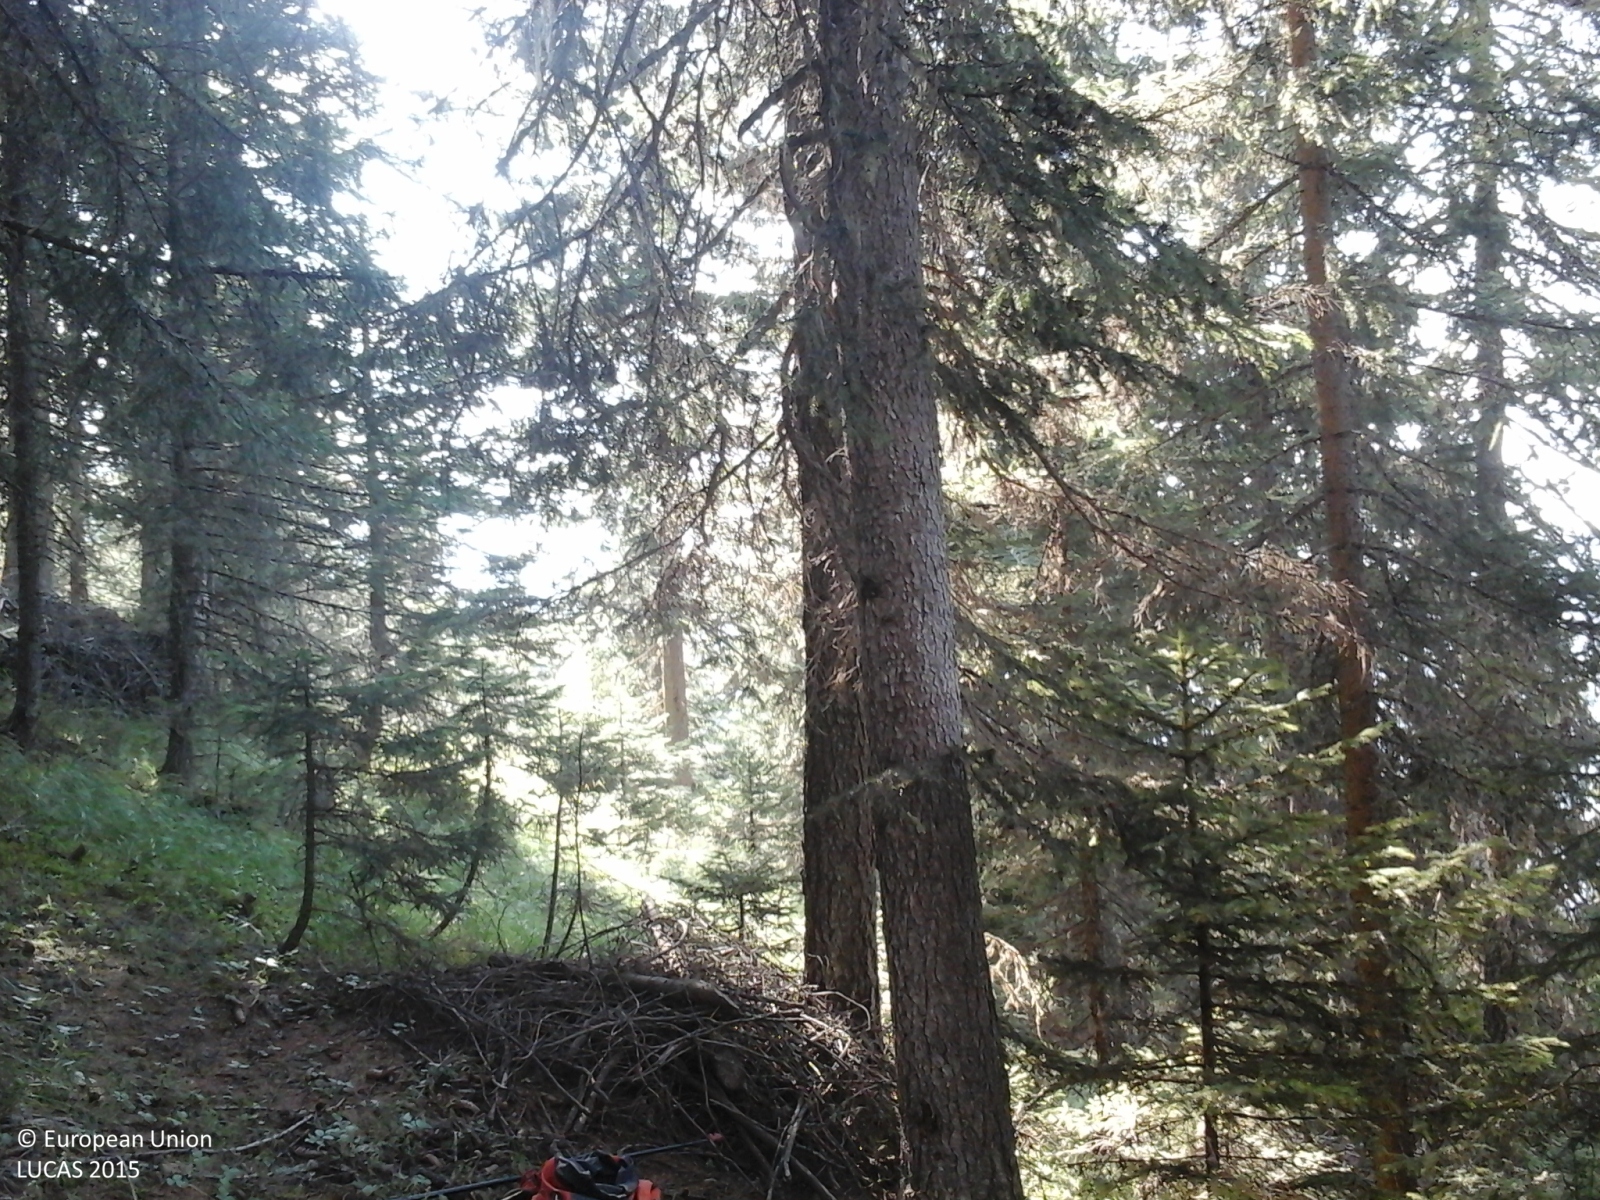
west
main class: Woodland
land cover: Other coniferous woodland
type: alpine coniferous forest
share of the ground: > 75 %
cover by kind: coniferous forest trees 100 %
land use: Forestry
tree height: > 5 m
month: August
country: IT
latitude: 45.6855
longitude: 7.2689
